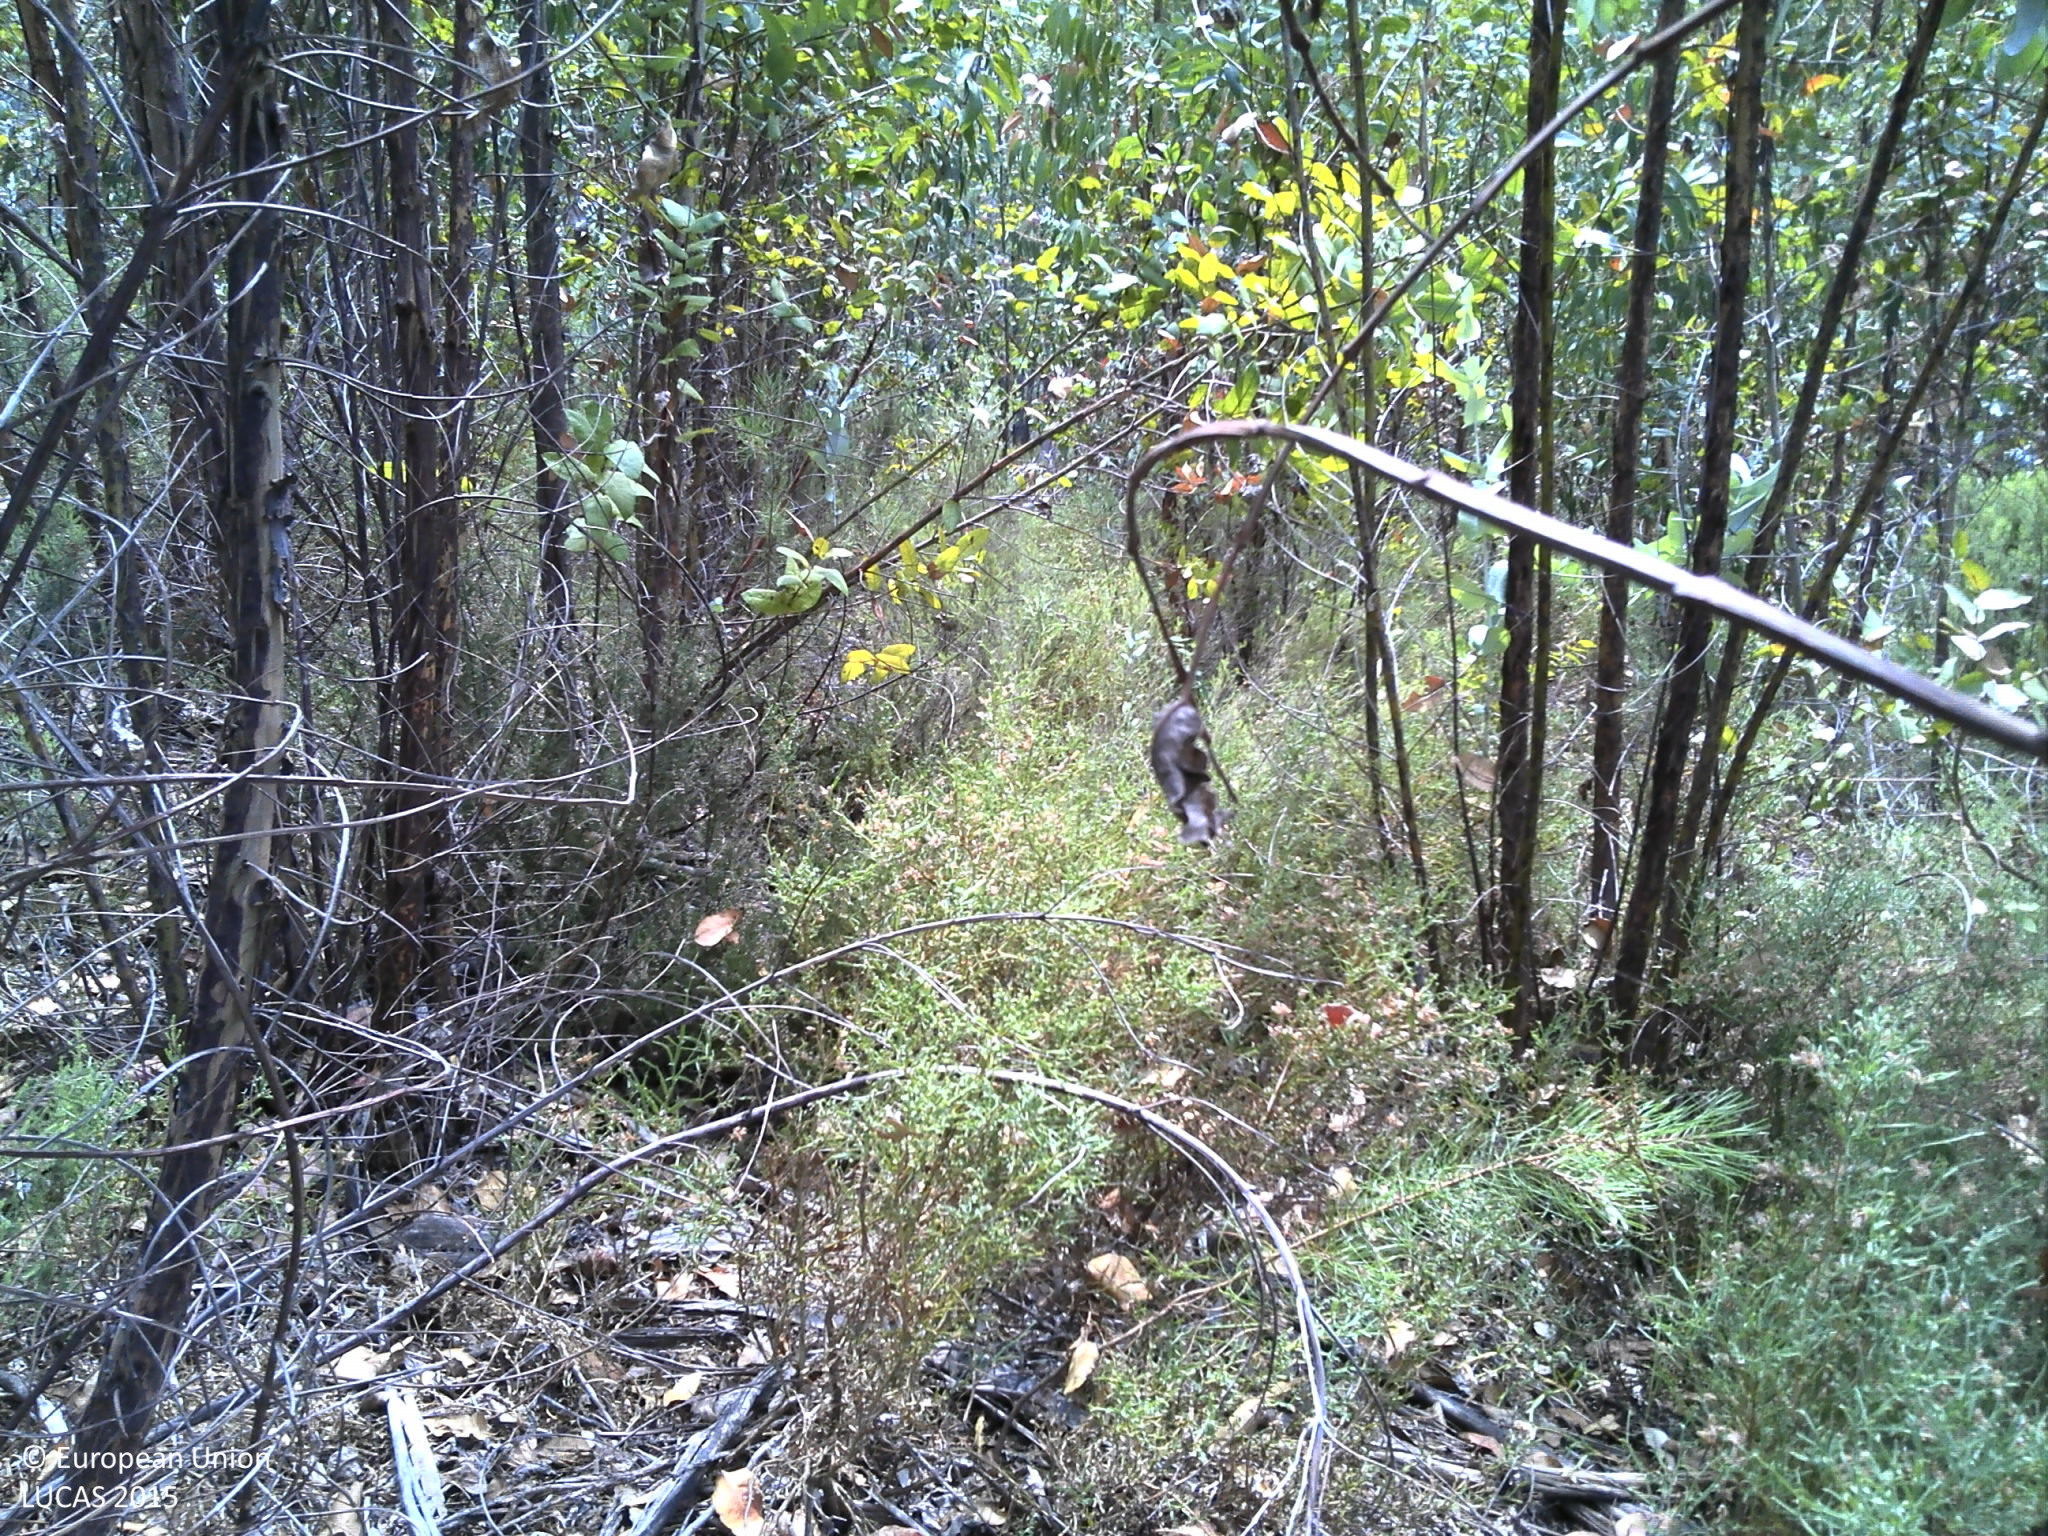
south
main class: Woodland
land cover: Pine dominated coniferous woodland
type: coniferous forest of the mediterranean region
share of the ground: 25 - 50 %
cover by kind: shrubs 50 %, coniferous forest trees 30 %, unconsolidated bare surface 20 %
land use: Forestry
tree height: > 5 m
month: July
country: PT
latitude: 39.9034
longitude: -7.8776
